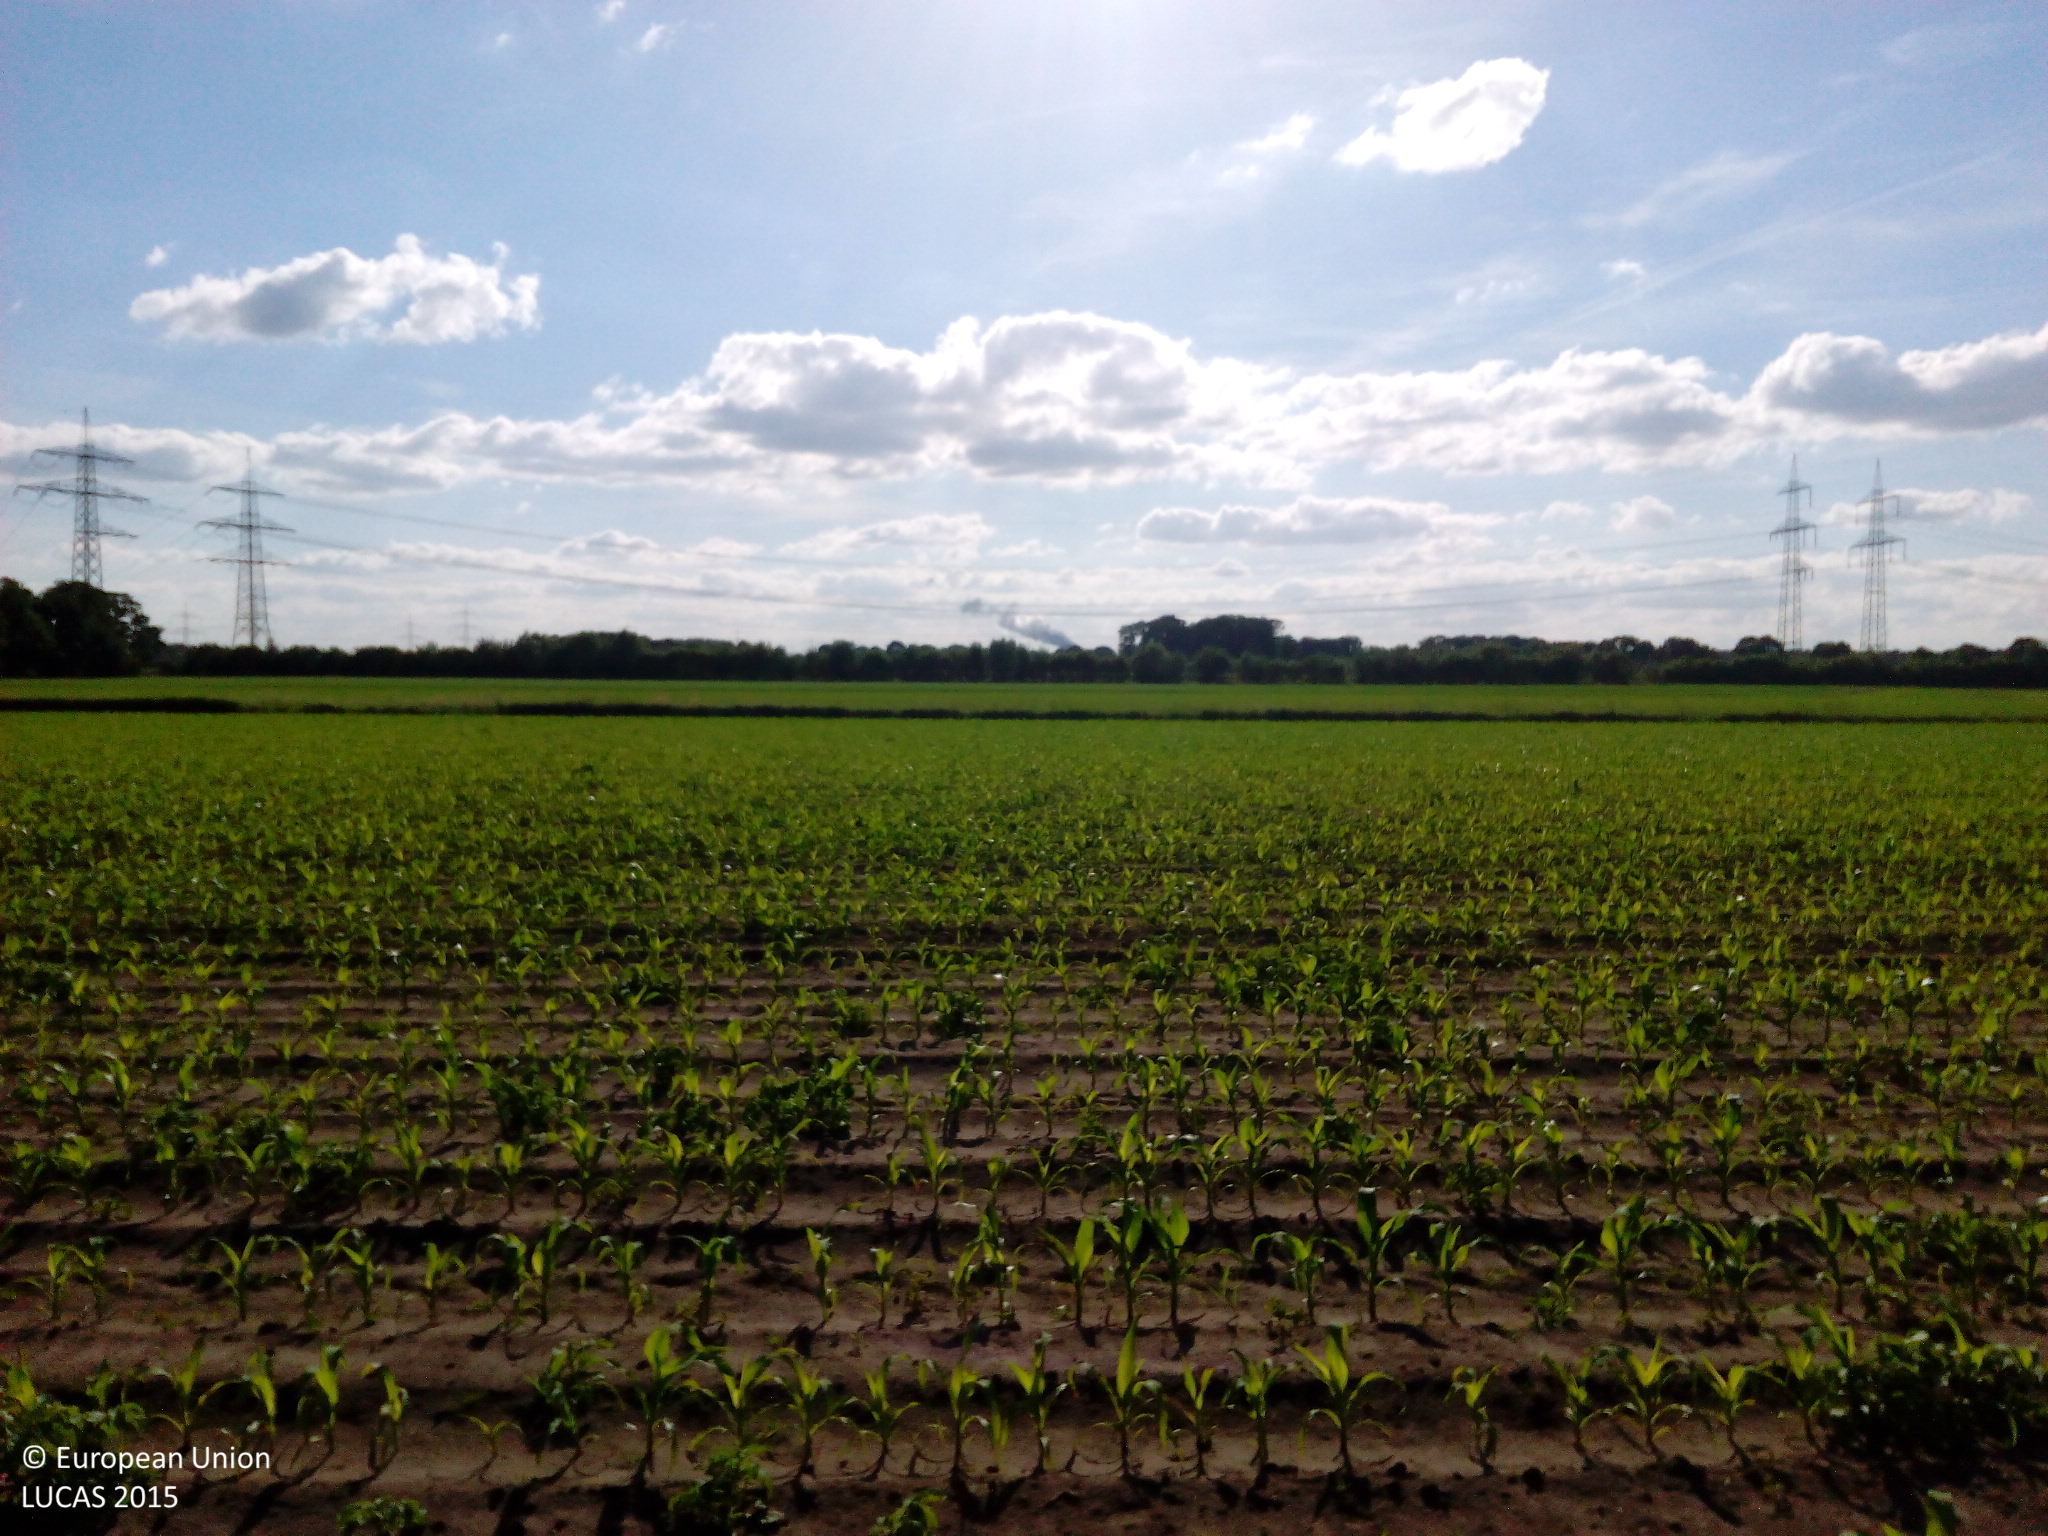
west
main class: Cropland
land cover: Maize
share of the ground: 10 - 25 %
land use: Agriculture (excluding fallow land and kitchen gardens)
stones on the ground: < 10 %
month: June
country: DE
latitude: 52.4754
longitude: 7.4239
